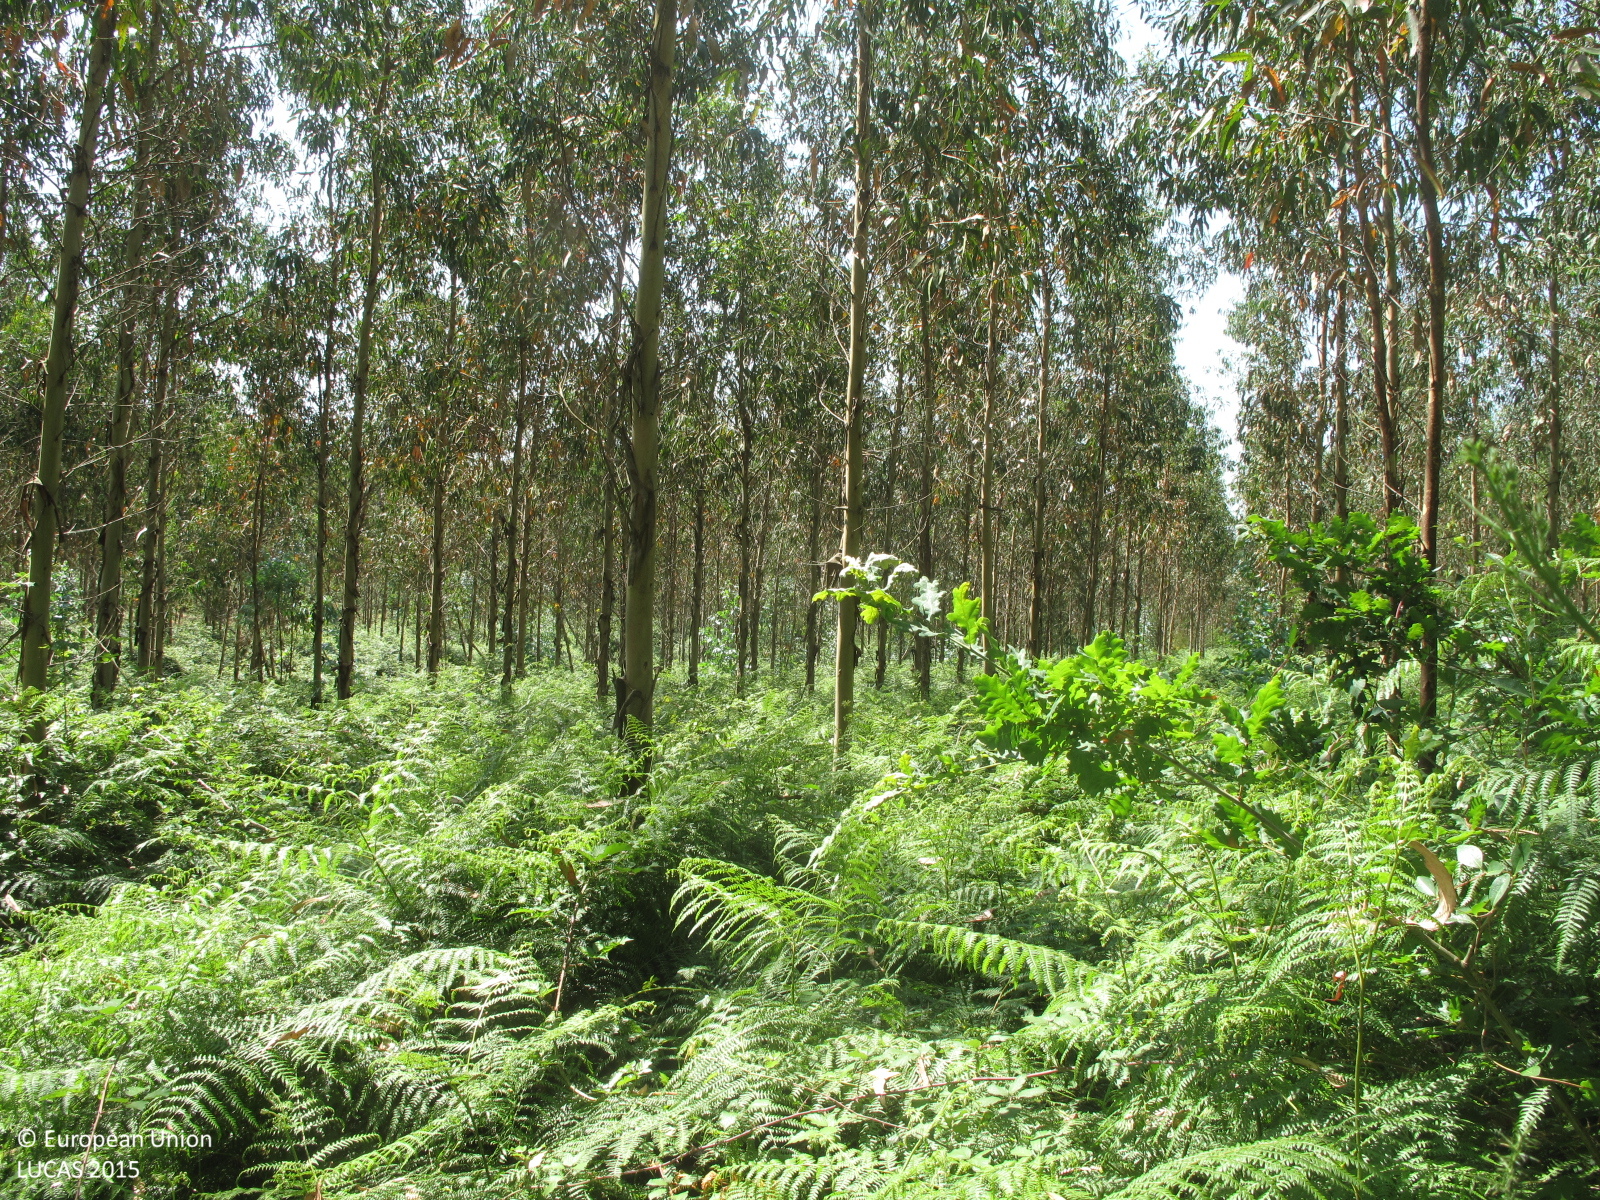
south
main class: Woodland
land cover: Broadleaved woodland
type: exotic forest
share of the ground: 50 - 75 %
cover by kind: broadleaved forest trees 50 %, herbaceous plants 30 %, shrubs 20 %
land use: Forestry
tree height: > 5 m
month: July
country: ES
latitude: 43.2865
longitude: -8.2546
